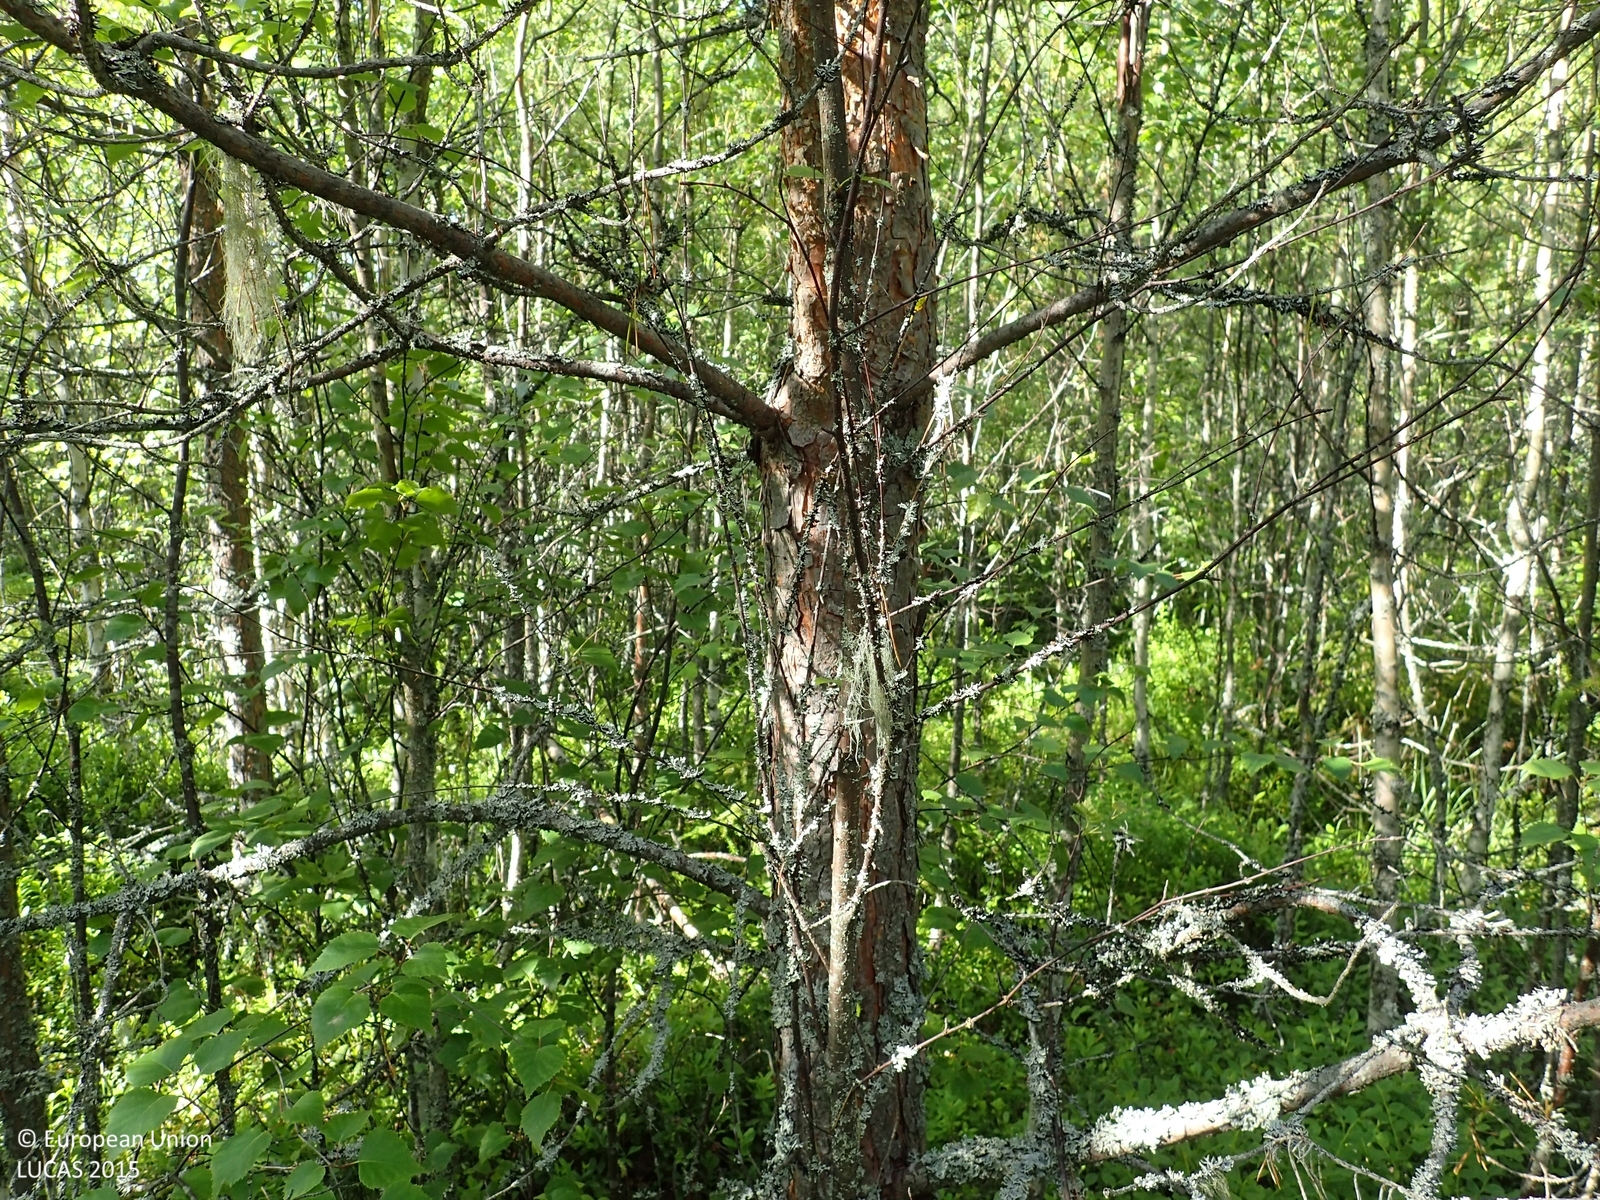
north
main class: Woodland
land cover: Pine dominated mixed woodland
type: boreal forest
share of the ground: > 75 %
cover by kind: coniferous forest trees 40 %, broadleaved forest trees 40 %, shrubs 10 %, herbaceous plants 10 %
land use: Forestry
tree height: > 5 m
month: June
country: FI
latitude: 62.5036
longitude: 21.4392
